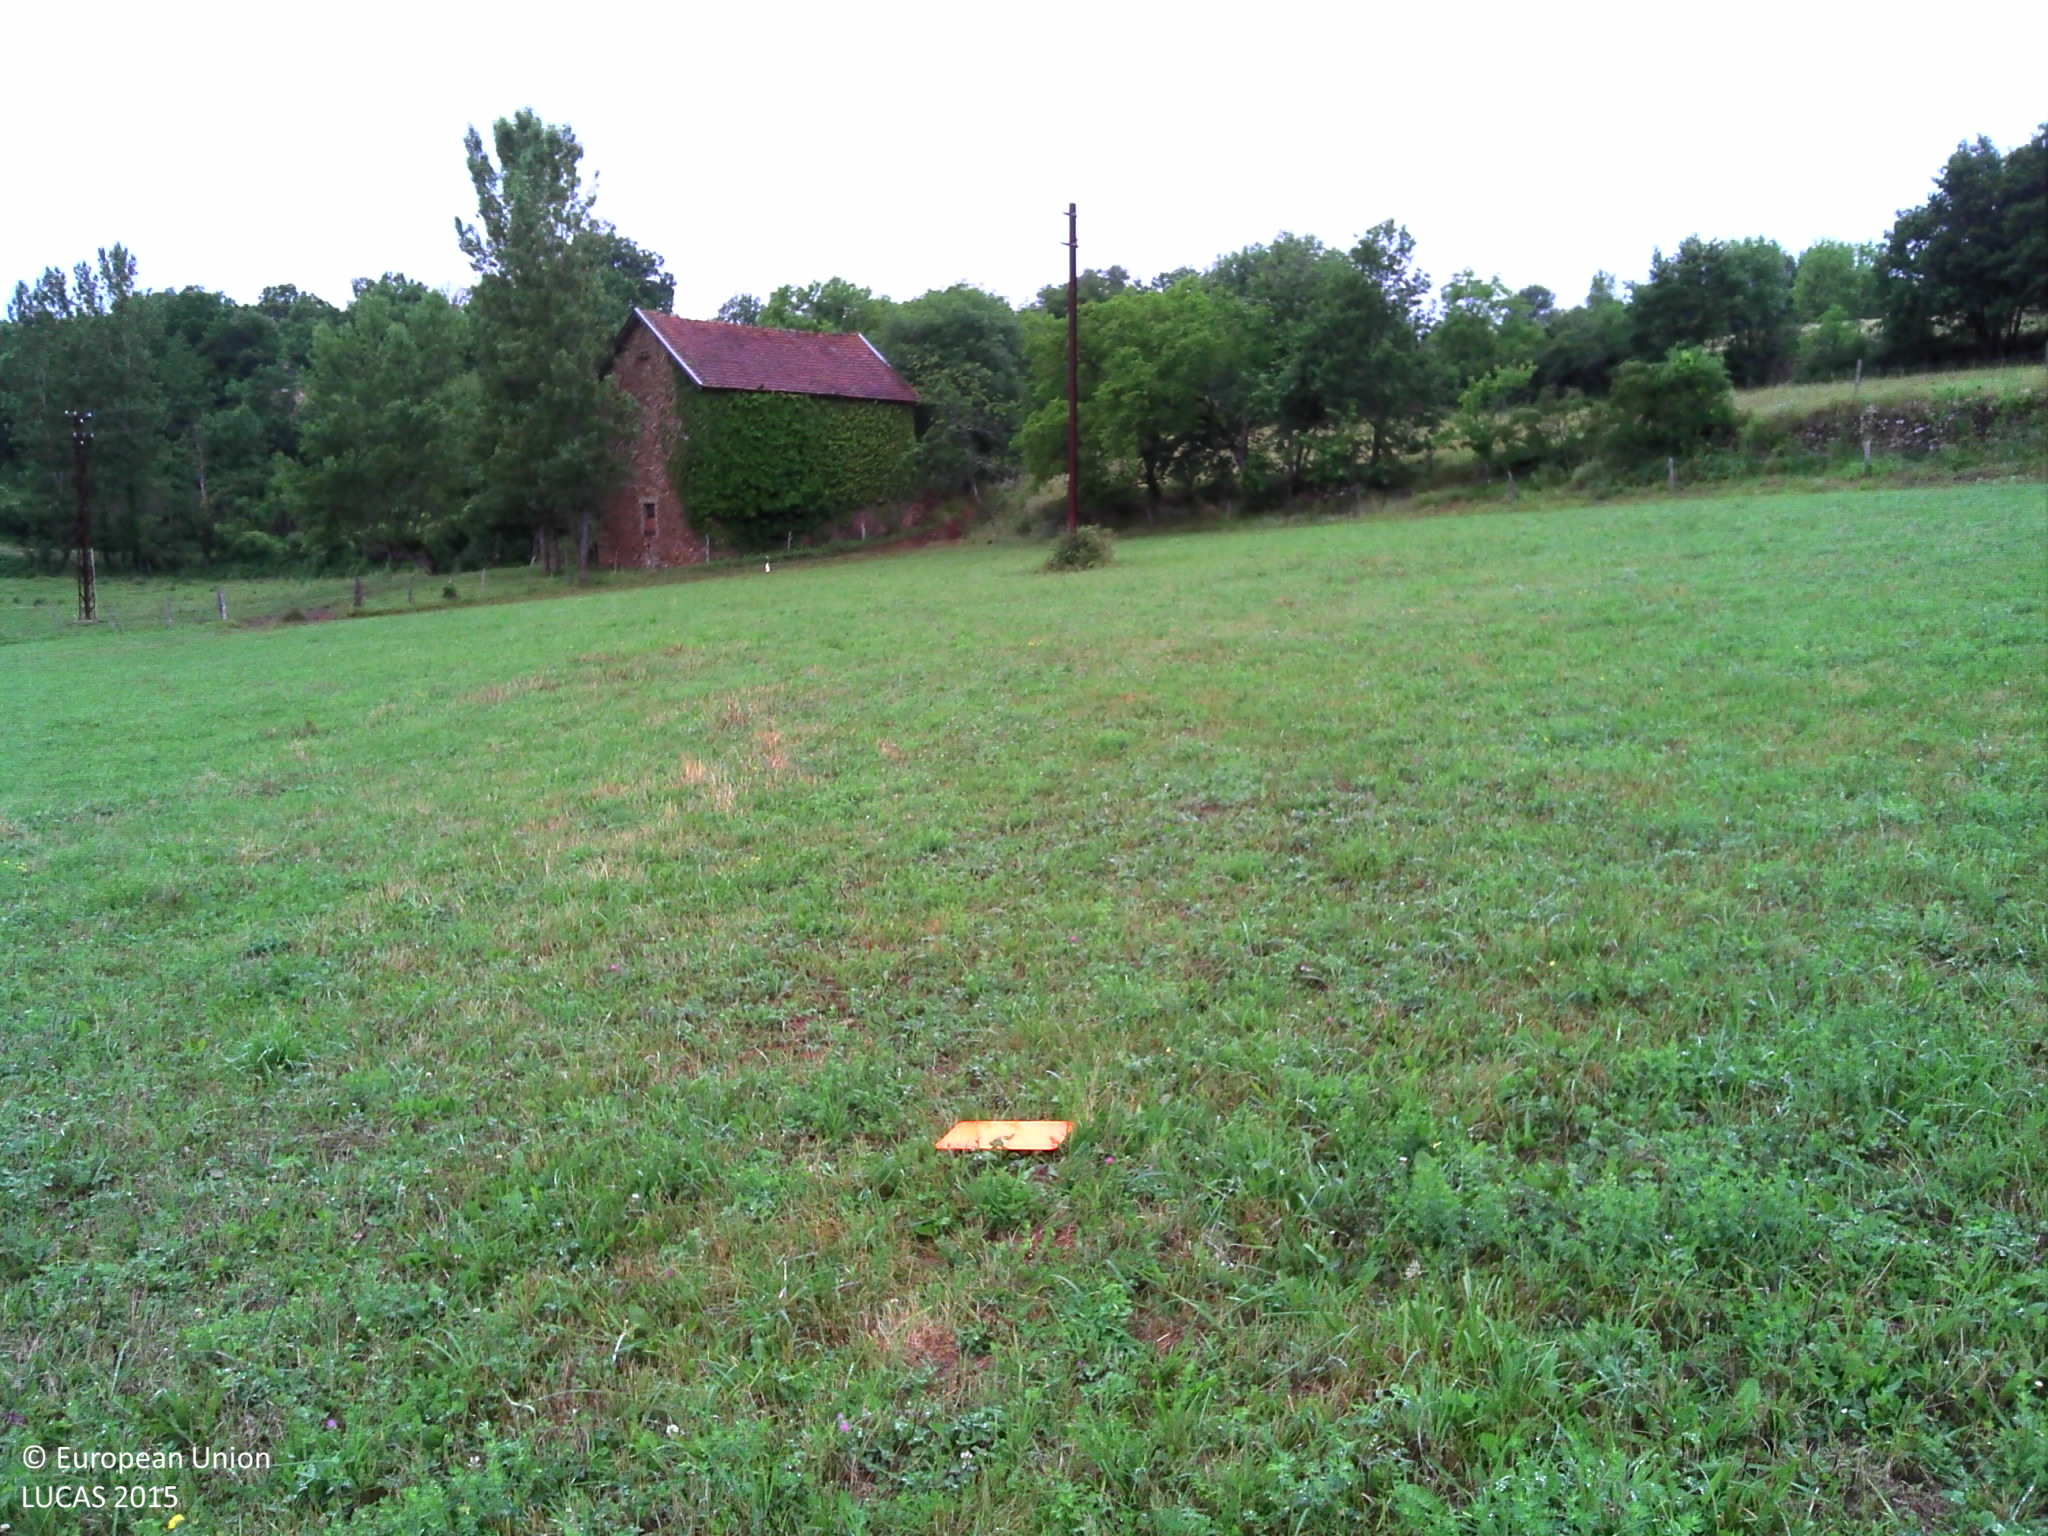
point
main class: Grassland
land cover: Grassland without tree/shrub cover
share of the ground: > 75 %
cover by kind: herbaceous plants 100 %
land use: Agriculture (excluding fallow land and kitchen gardens)
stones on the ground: 10 - 25 %
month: June
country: FR
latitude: 44.3700
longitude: 2.0326
